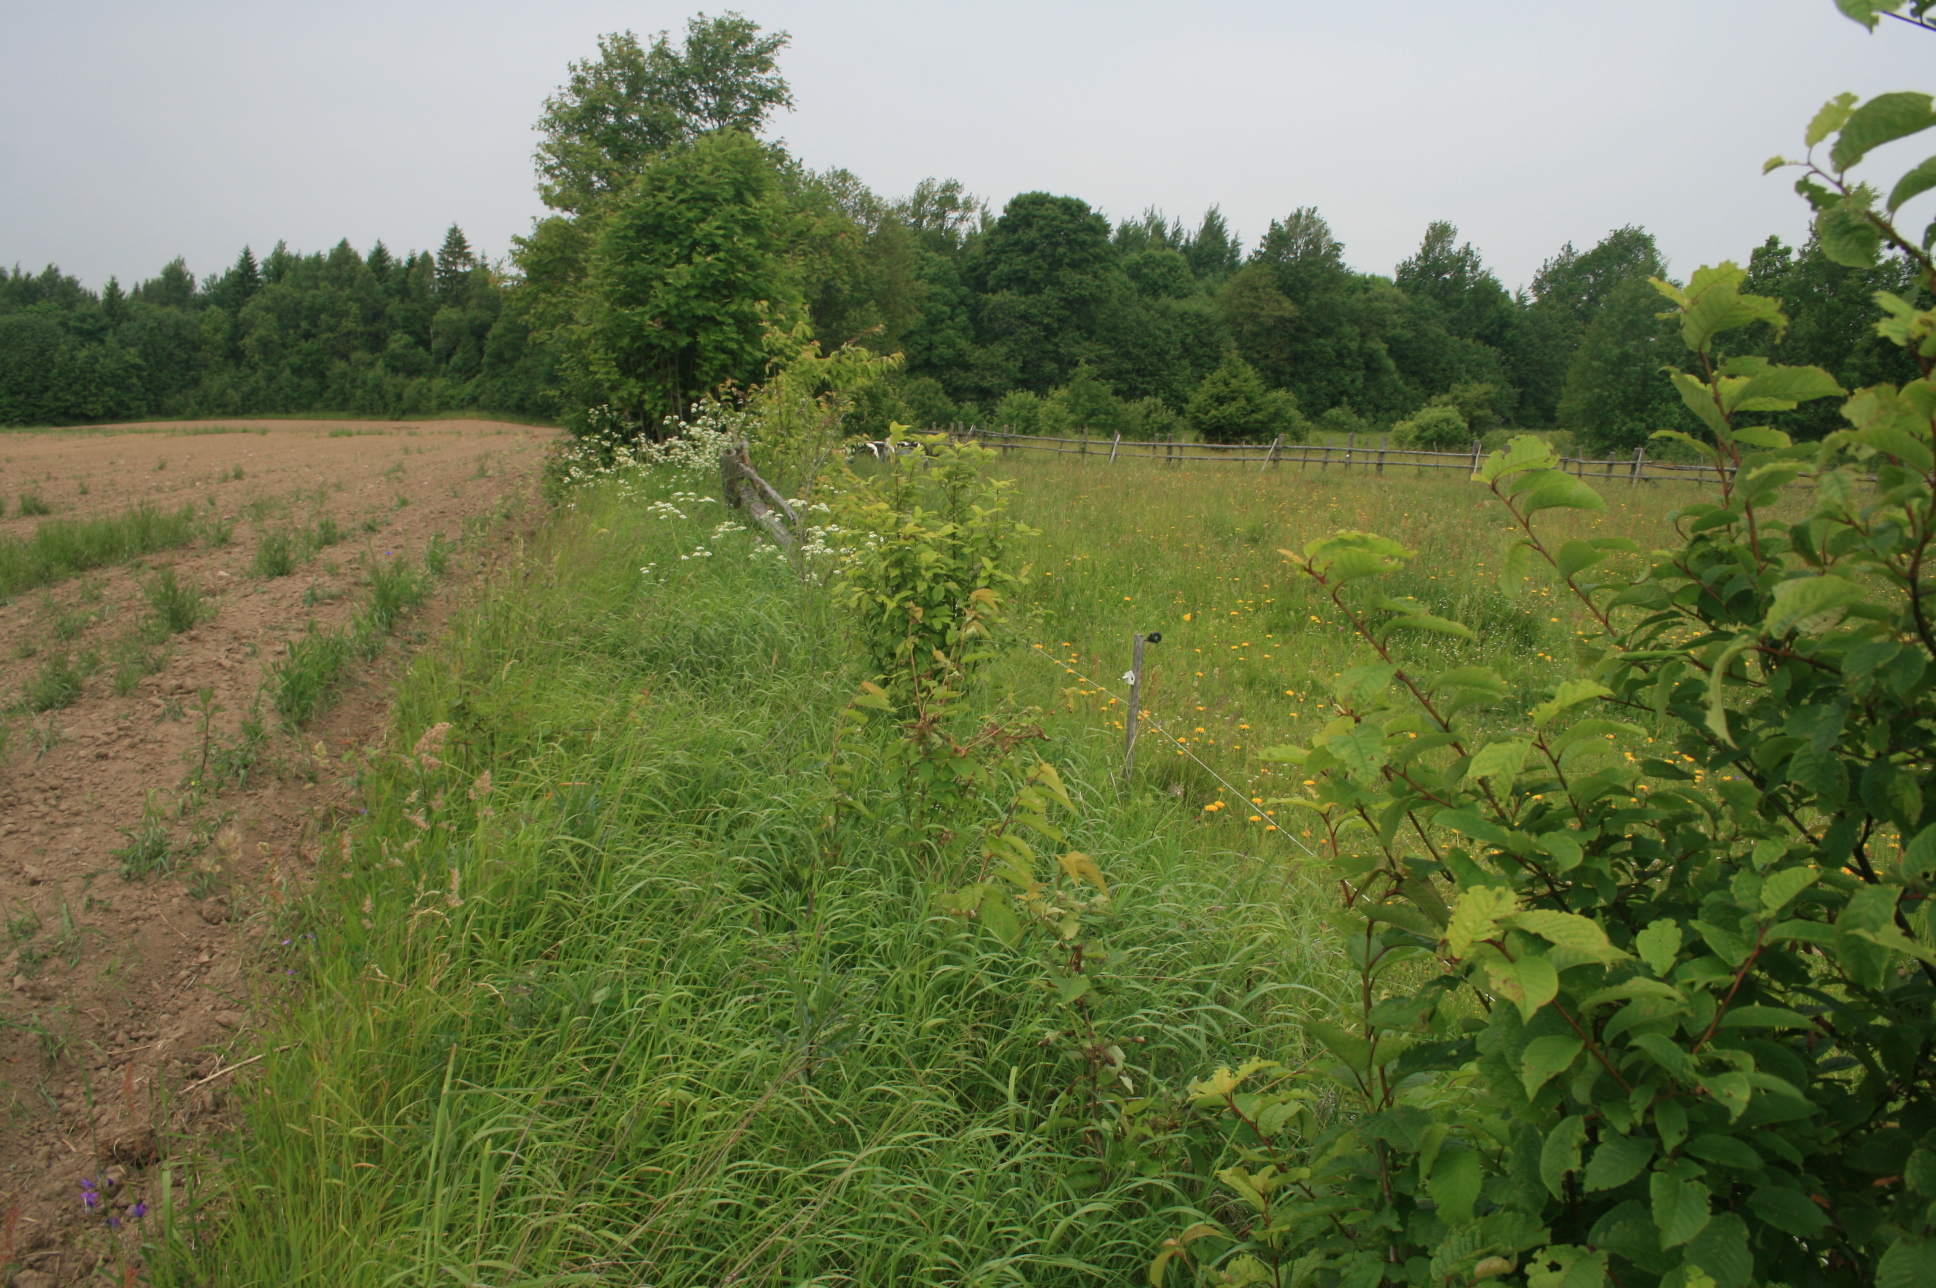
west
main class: Grassland
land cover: Grassland without tree/shrub cover
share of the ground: > 75 %
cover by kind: herbaceous plants 100 %
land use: Agriculture (excluding fallow land and kitchen gardens)
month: June
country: LT
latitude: 55.7208
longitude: 22.2995
